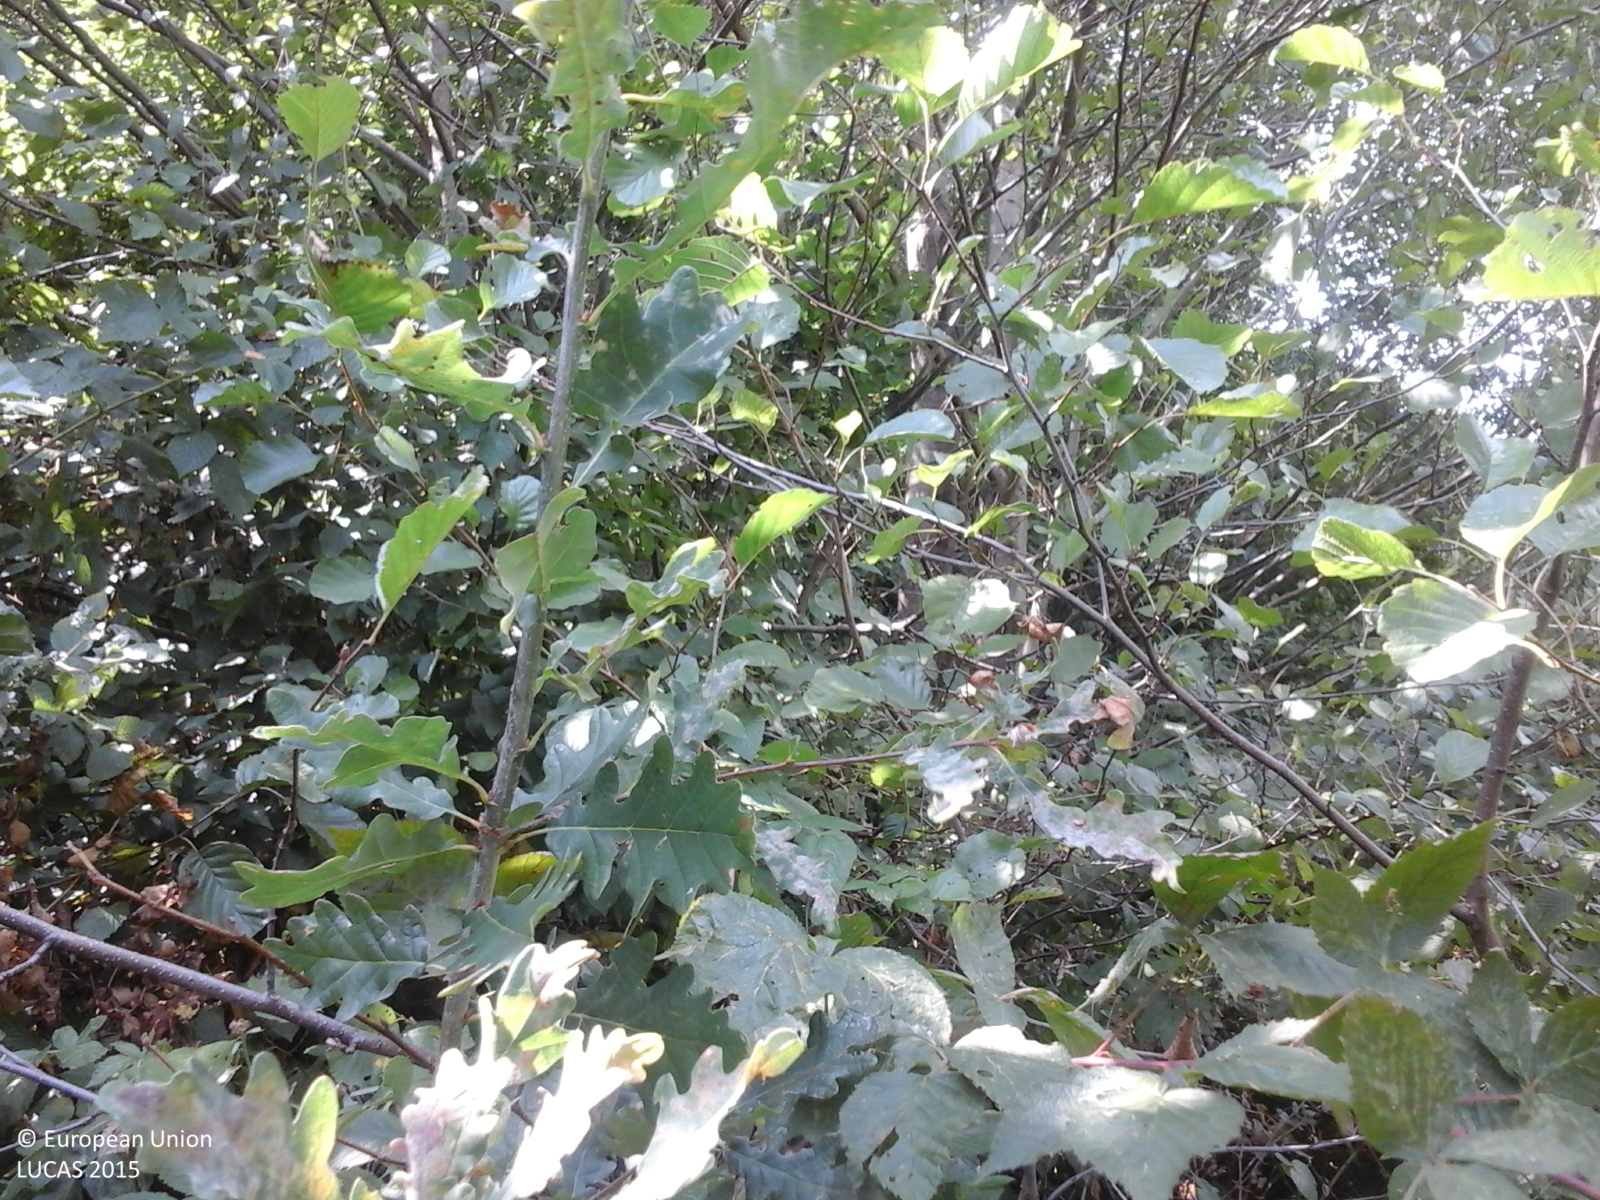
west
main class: Woodland
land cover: Broadleaved woodland
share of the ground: > 75 %
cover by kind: broadleaved forest trees 100 %
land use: Forestry
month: September
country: RO
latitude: 47.8132
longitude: 24.3141
